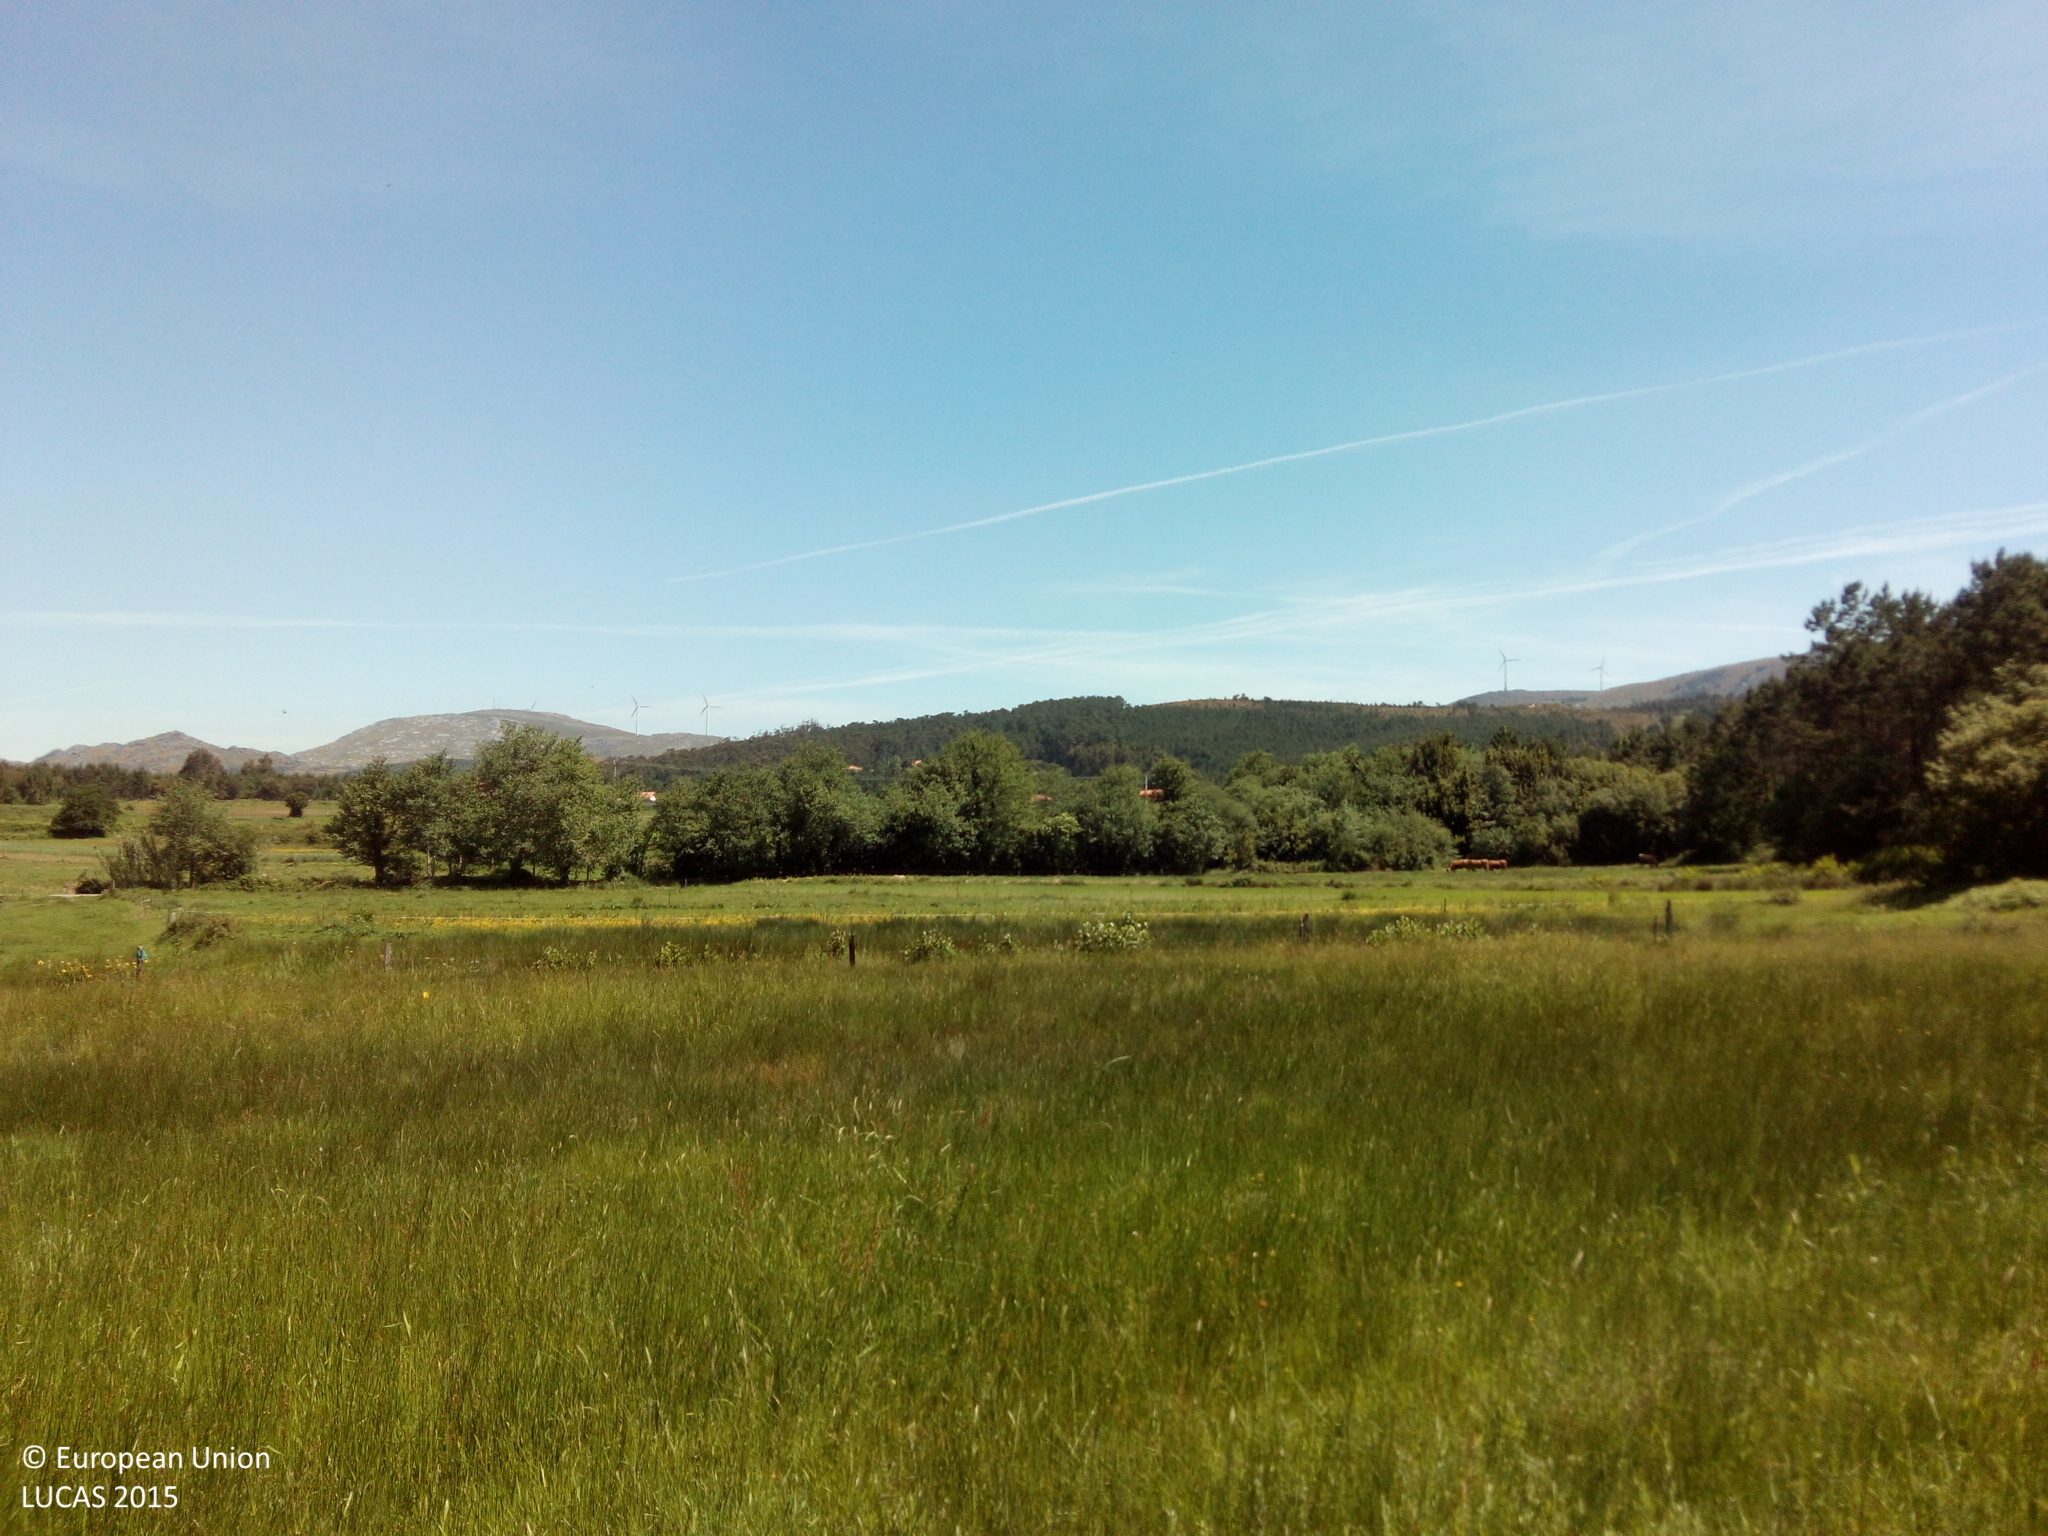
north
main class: Woodland
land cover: Broadleaved woodland
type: thermophilous deciduous forest
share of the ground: > 75 %
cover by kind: broadleaved forest trees 100 %
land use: Forestry
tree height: > 5 m
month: May
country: ES
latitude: 42.6251
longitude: -9.0279
